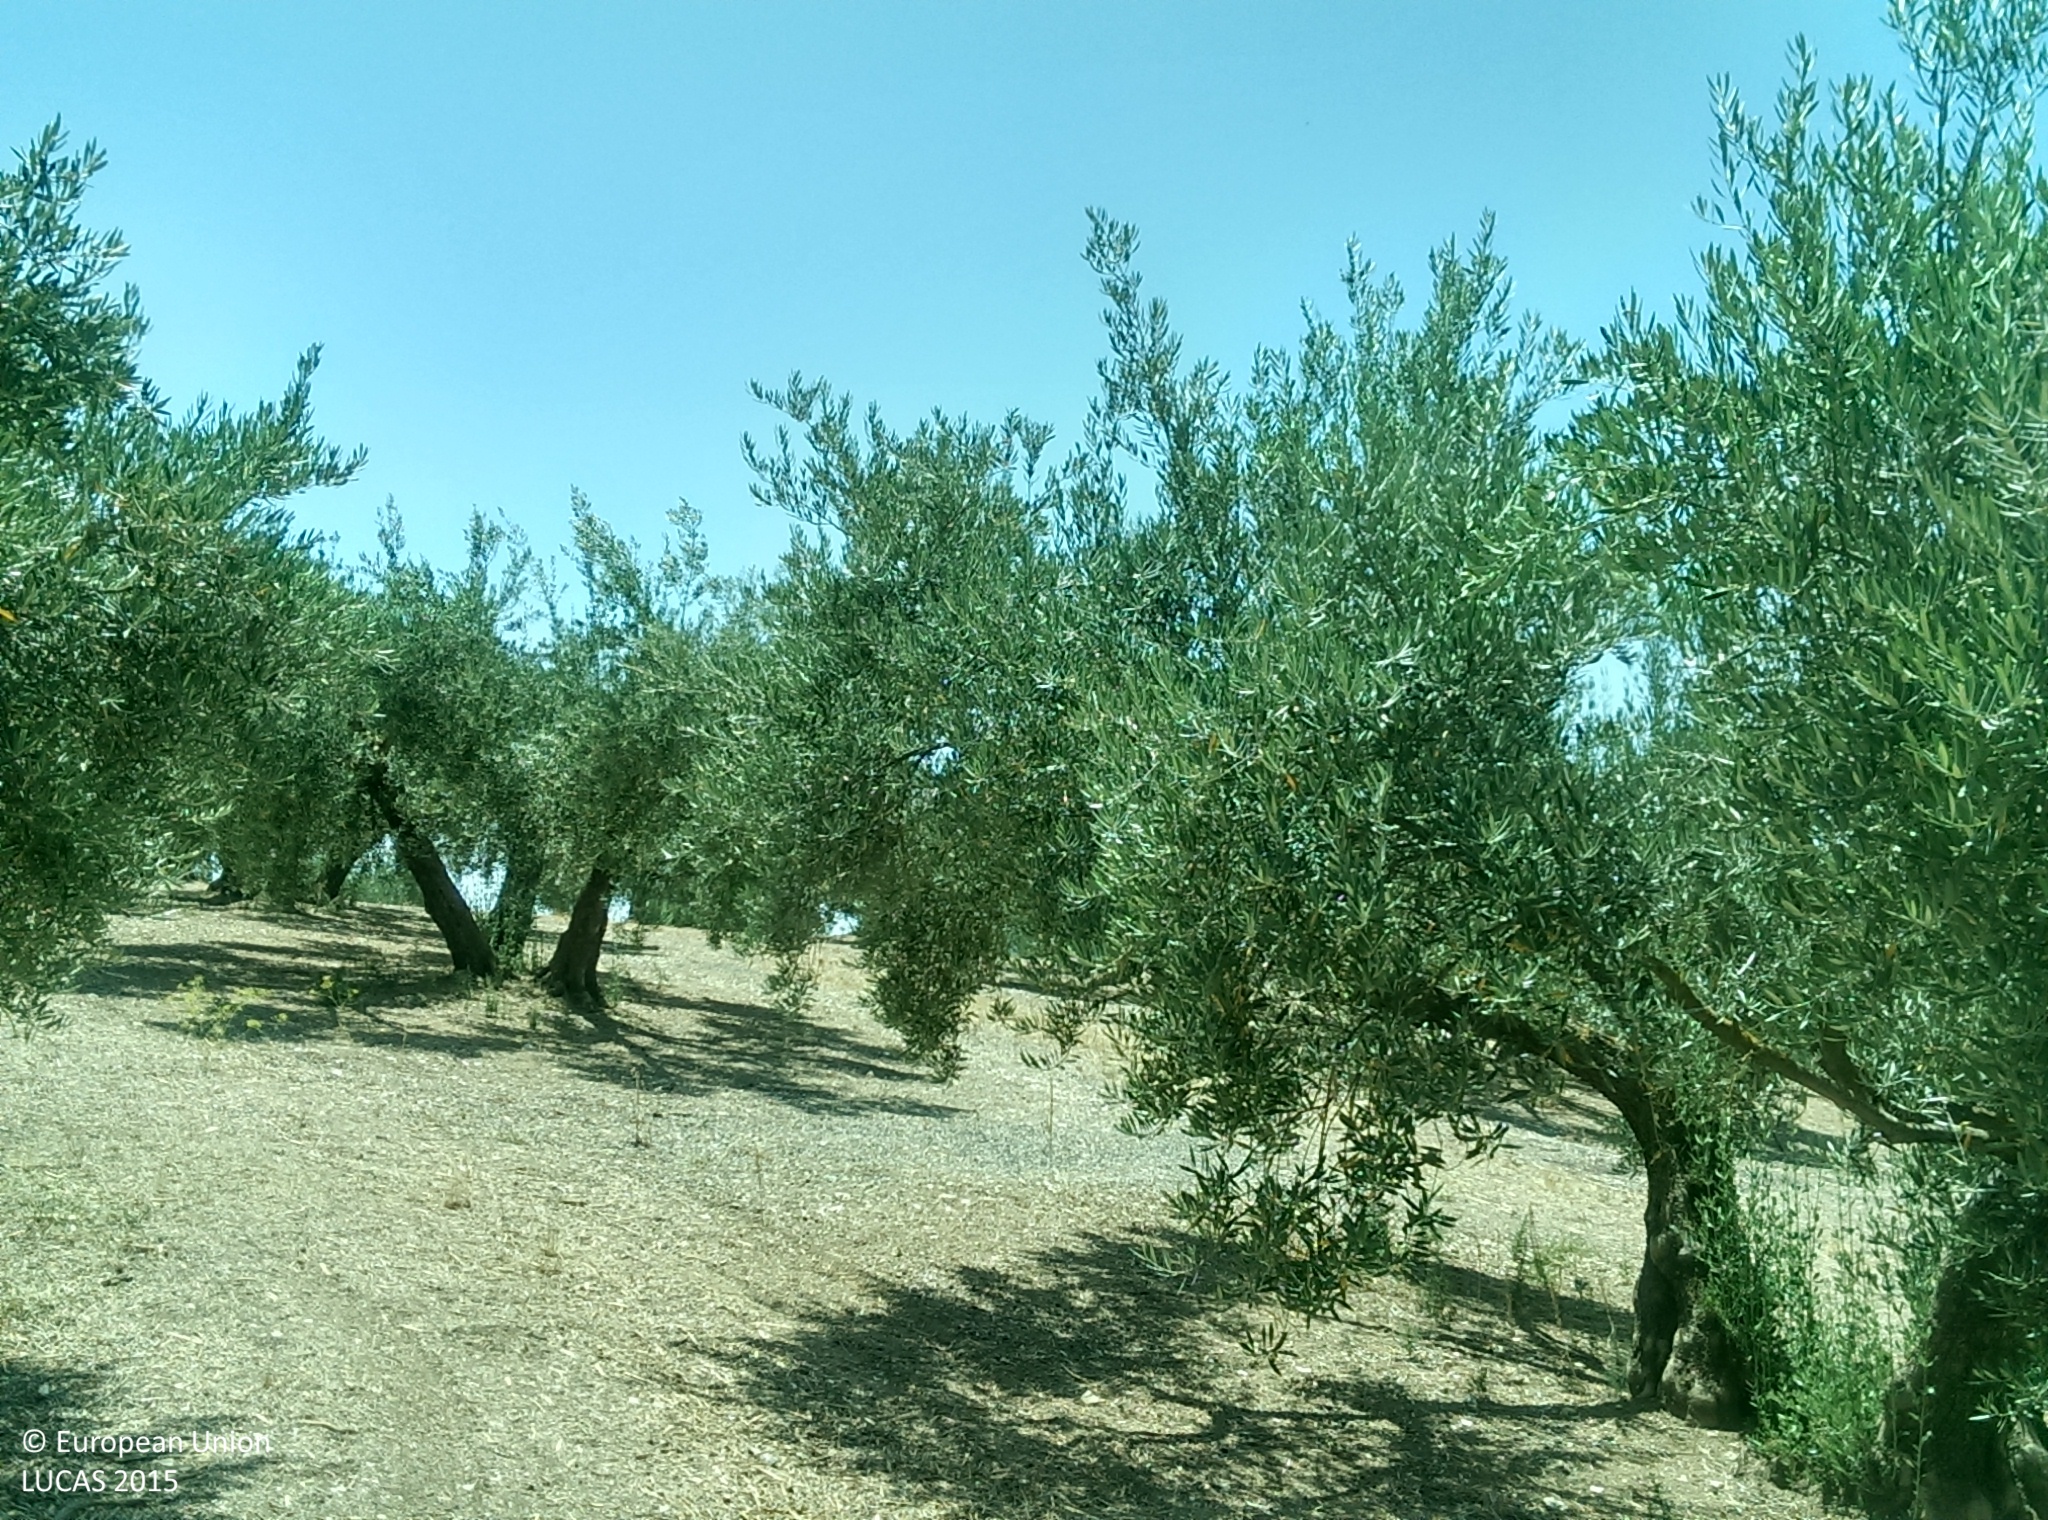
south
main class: Cropland
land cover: Olive groves
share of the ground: 50 - 75 %
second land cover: Spontaneously vegetated surfaces
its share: 10 - 25 %
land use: Agriculture (excluding fallow land and kitchen gardens)
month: July
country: ES
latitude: 37.4090
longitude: -3.7210
